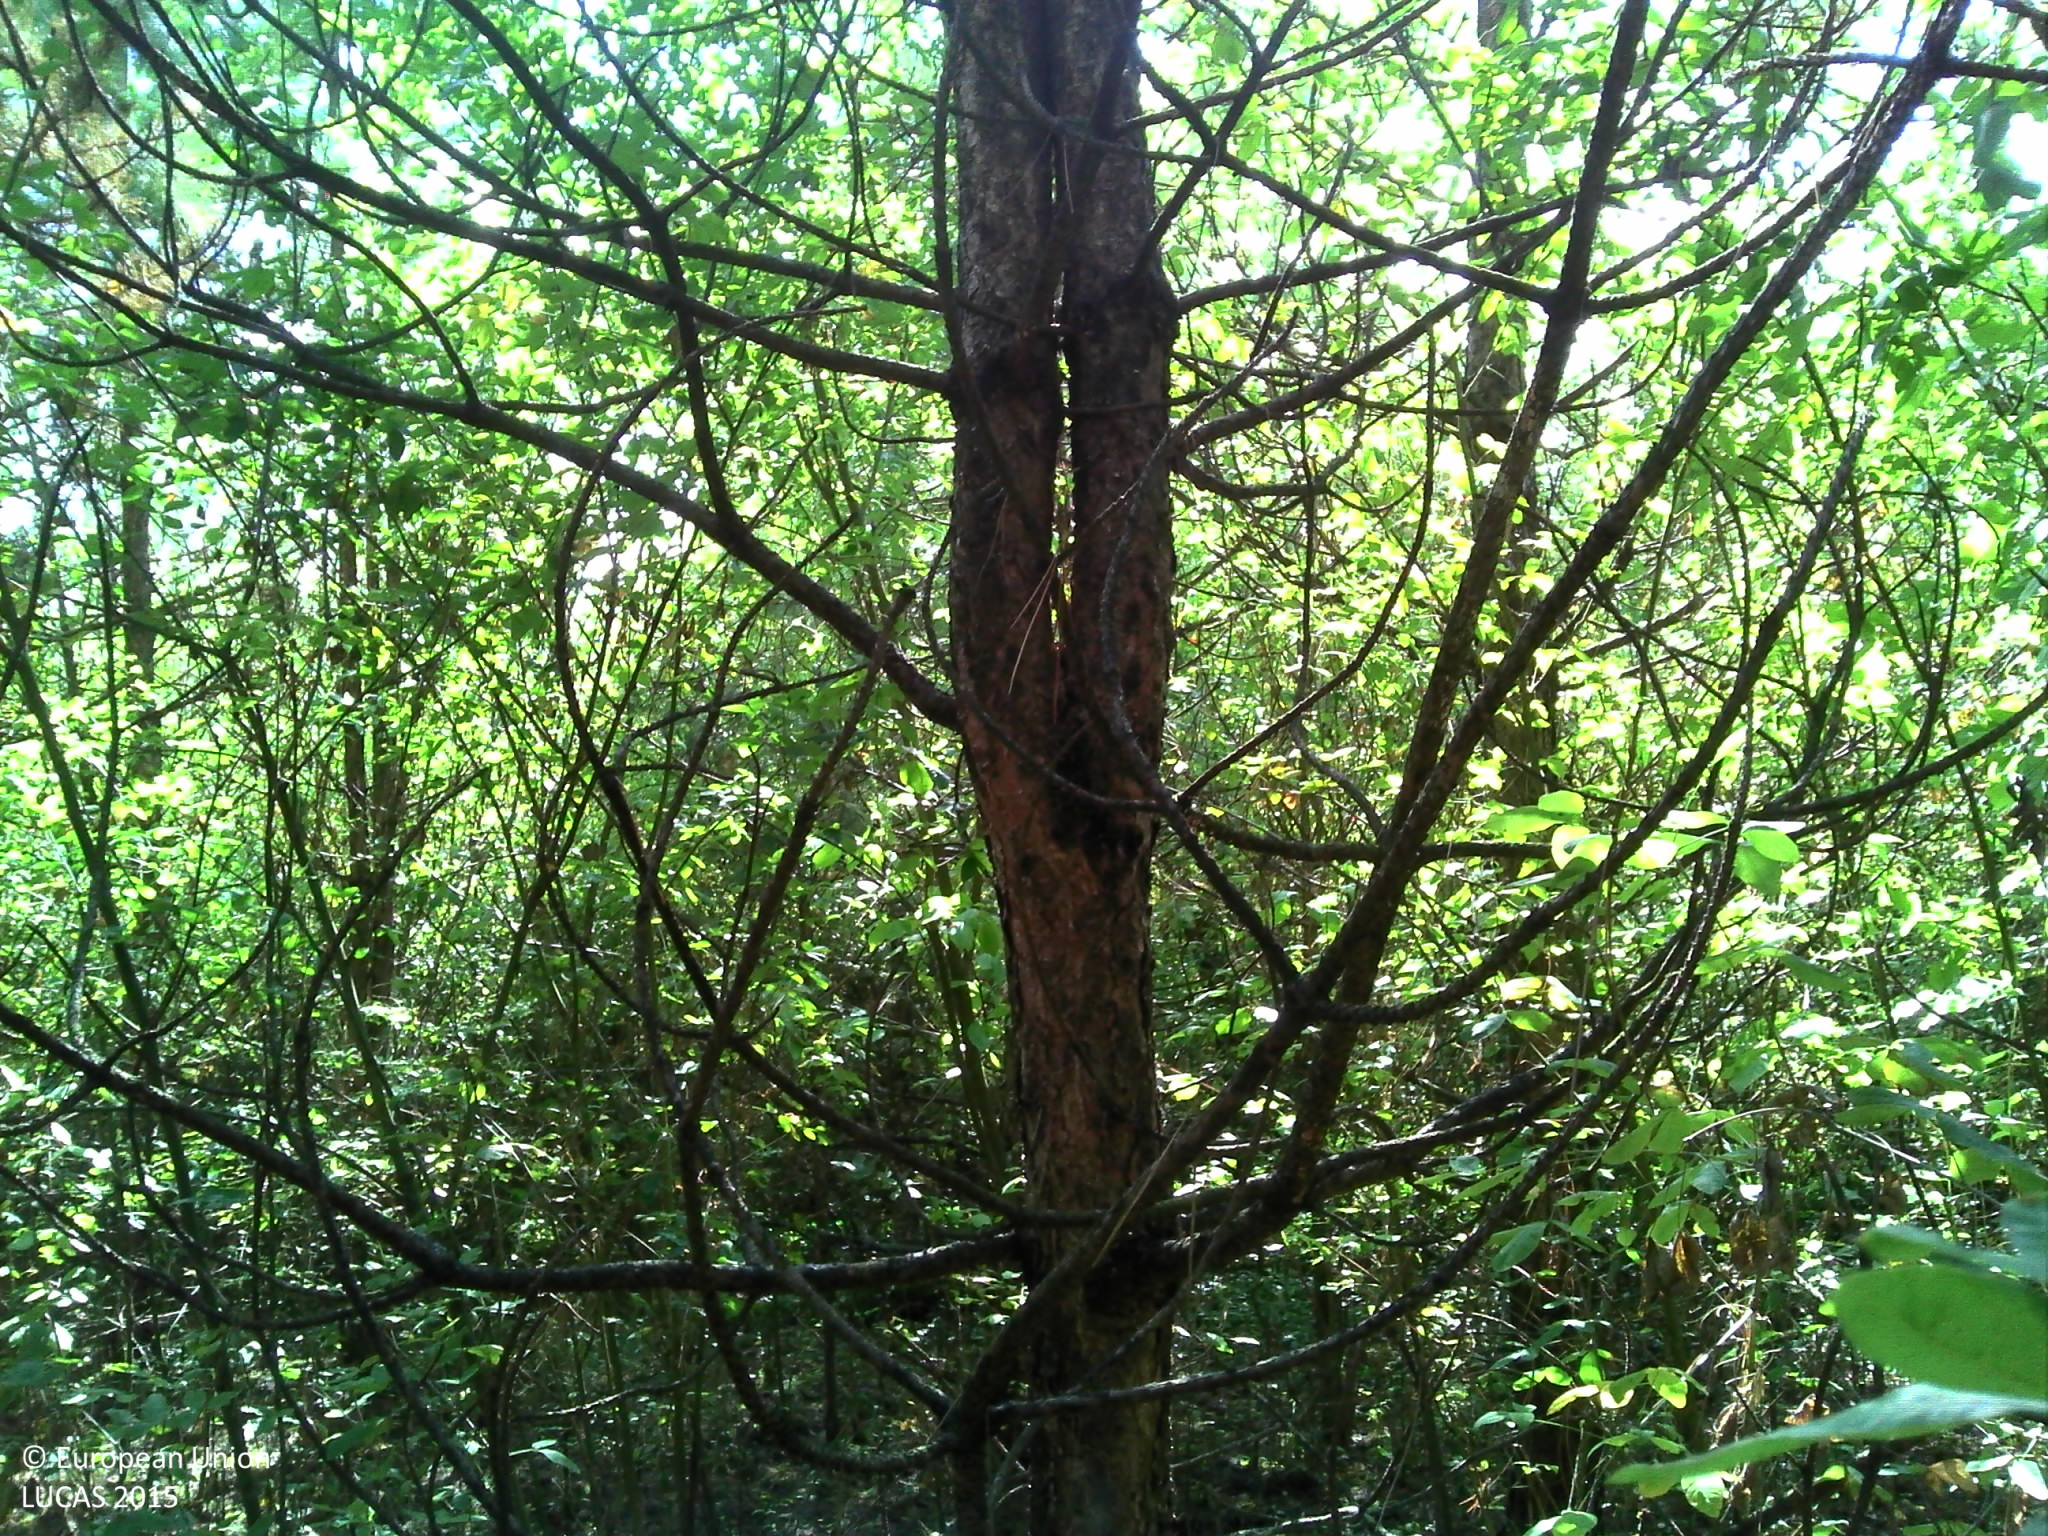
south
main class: Woodland
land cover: Pine dominated coniferous woodland
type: exotic forest
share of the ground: > 75 %
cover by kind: coniferous forest trees 100 %
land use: Forestry
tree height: > 5 m
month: September
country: FR
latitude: 48.3240
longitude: 4.2107
